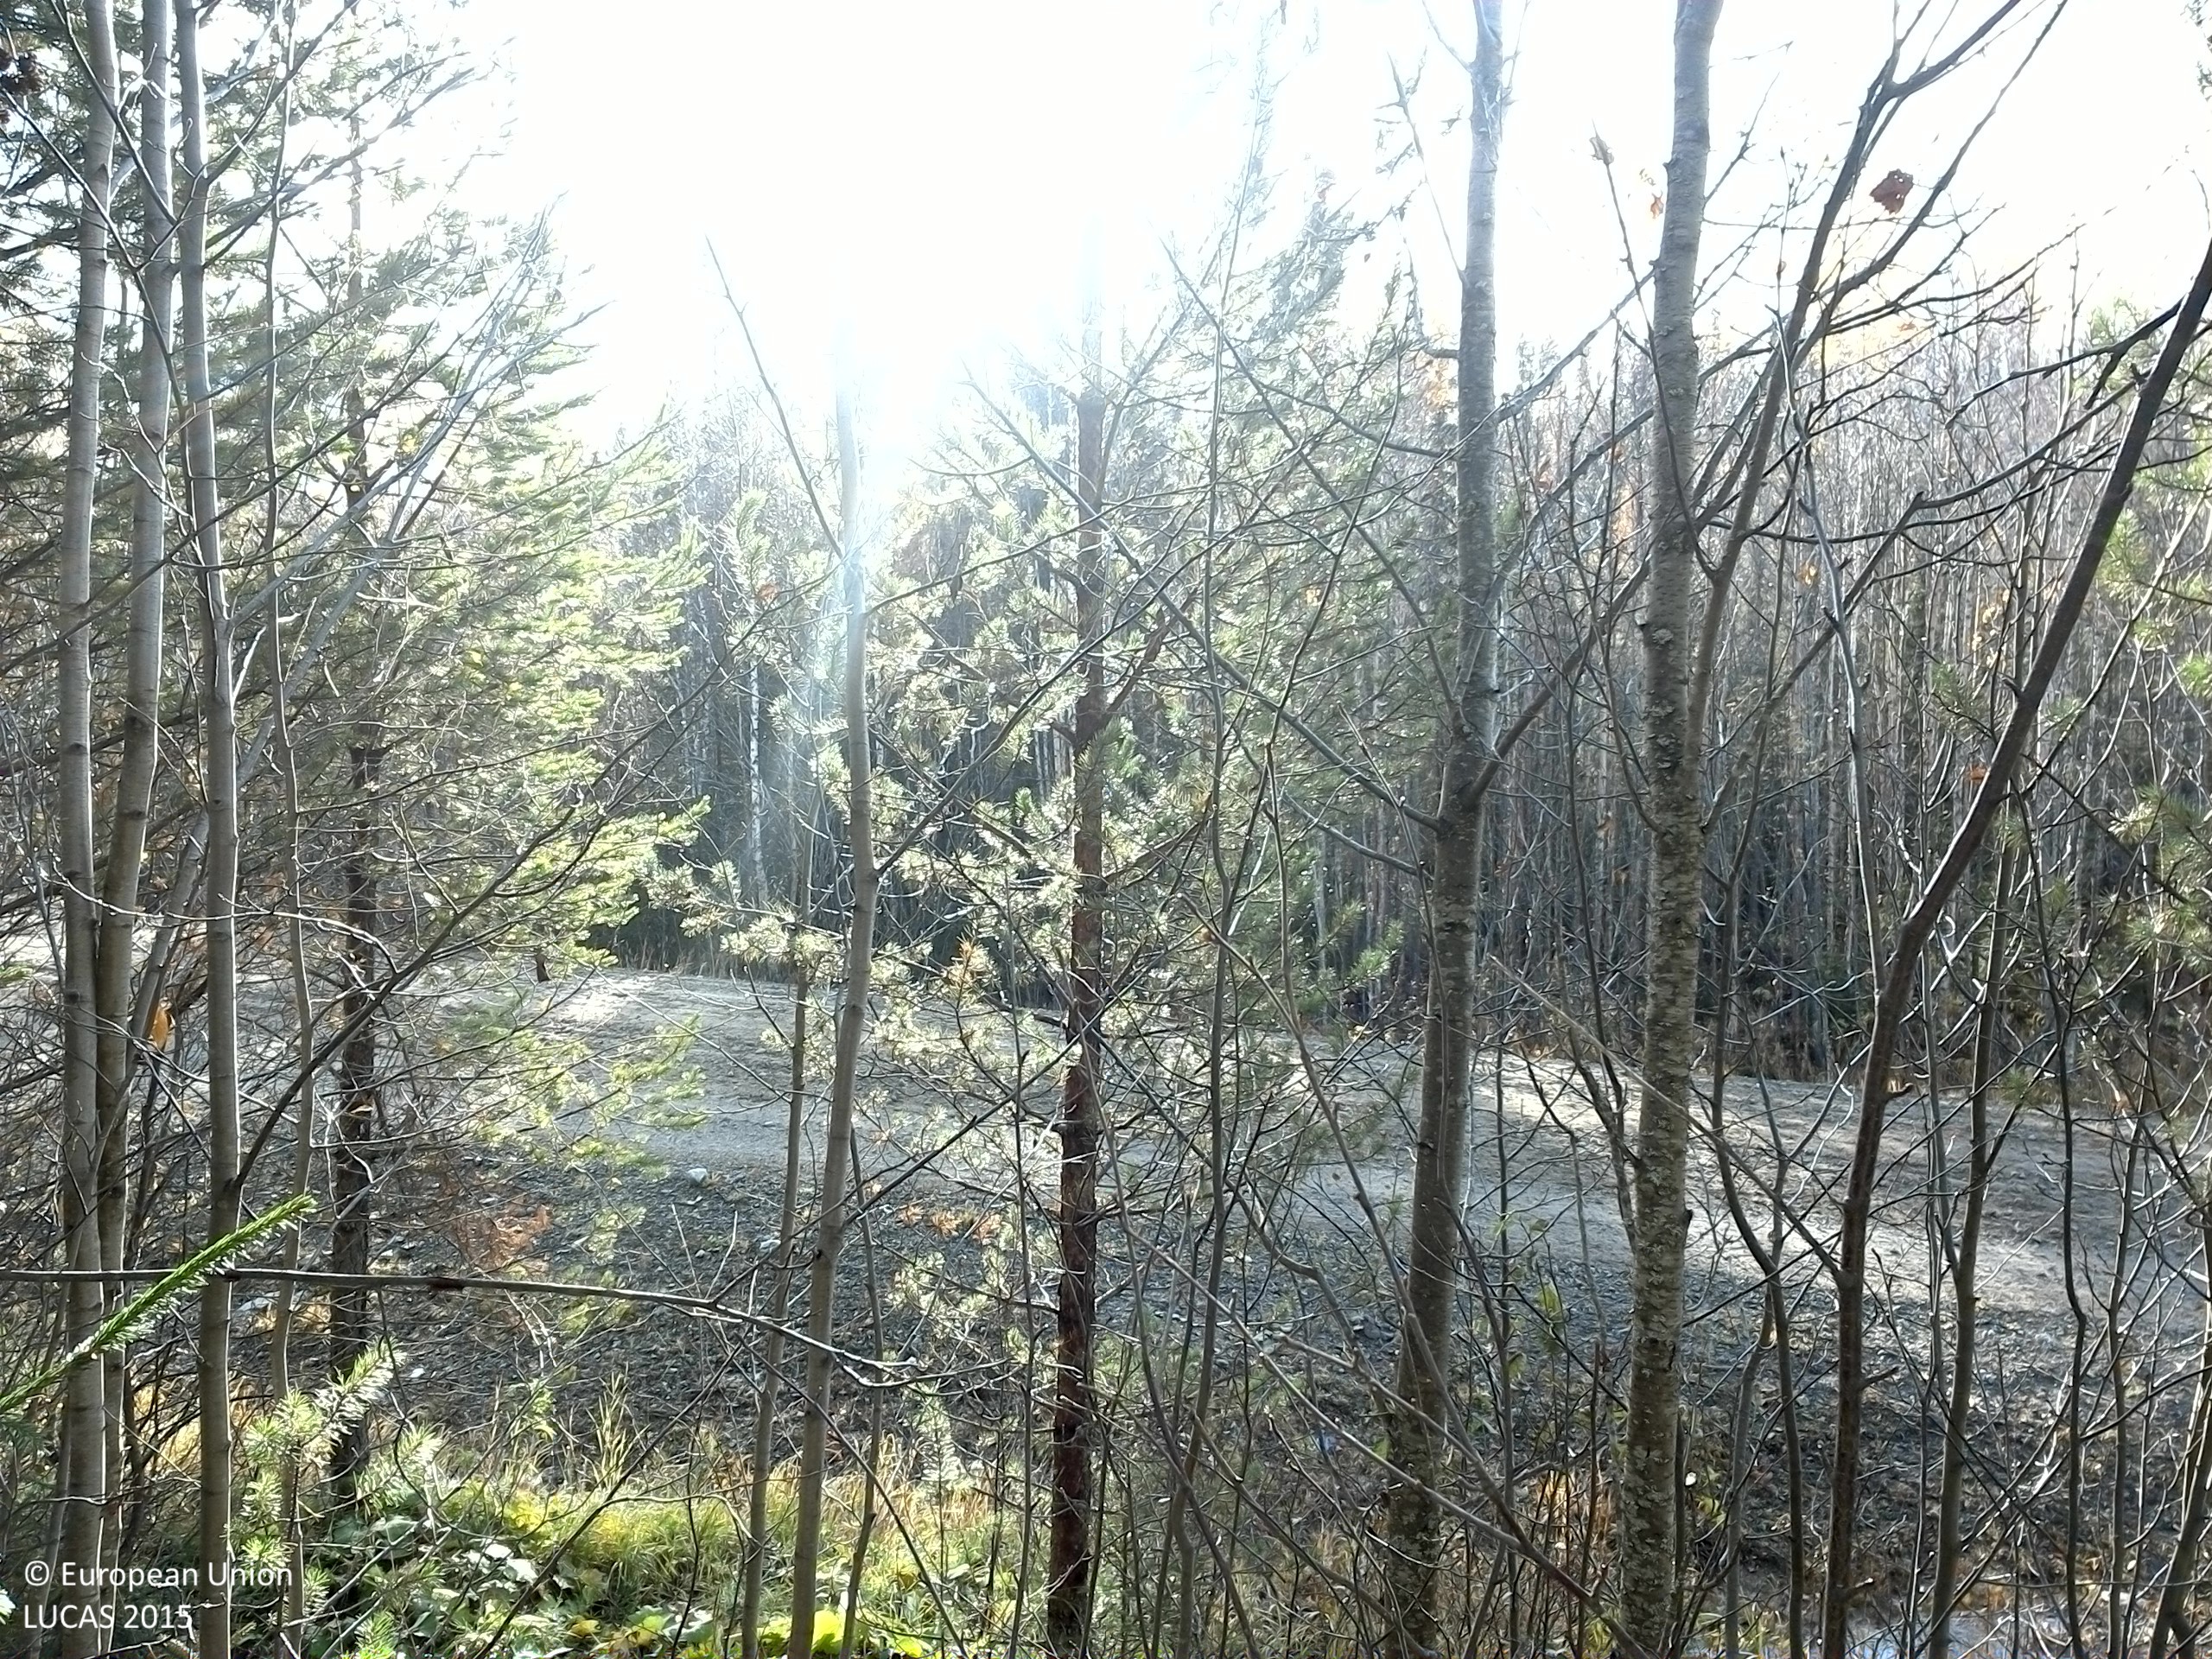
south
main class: Woodland
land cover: Pine dominated mixed woodland
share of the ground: 50 - 75 %
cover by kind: coniferous forest trees 35 %, shrubs 30 %, broadleaved forest trees 20 %, lichens and mosses 10 %, herbaceous plants 5 %
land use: Forestry
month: October
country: SE
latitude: 64.1011
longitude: 16.0653
